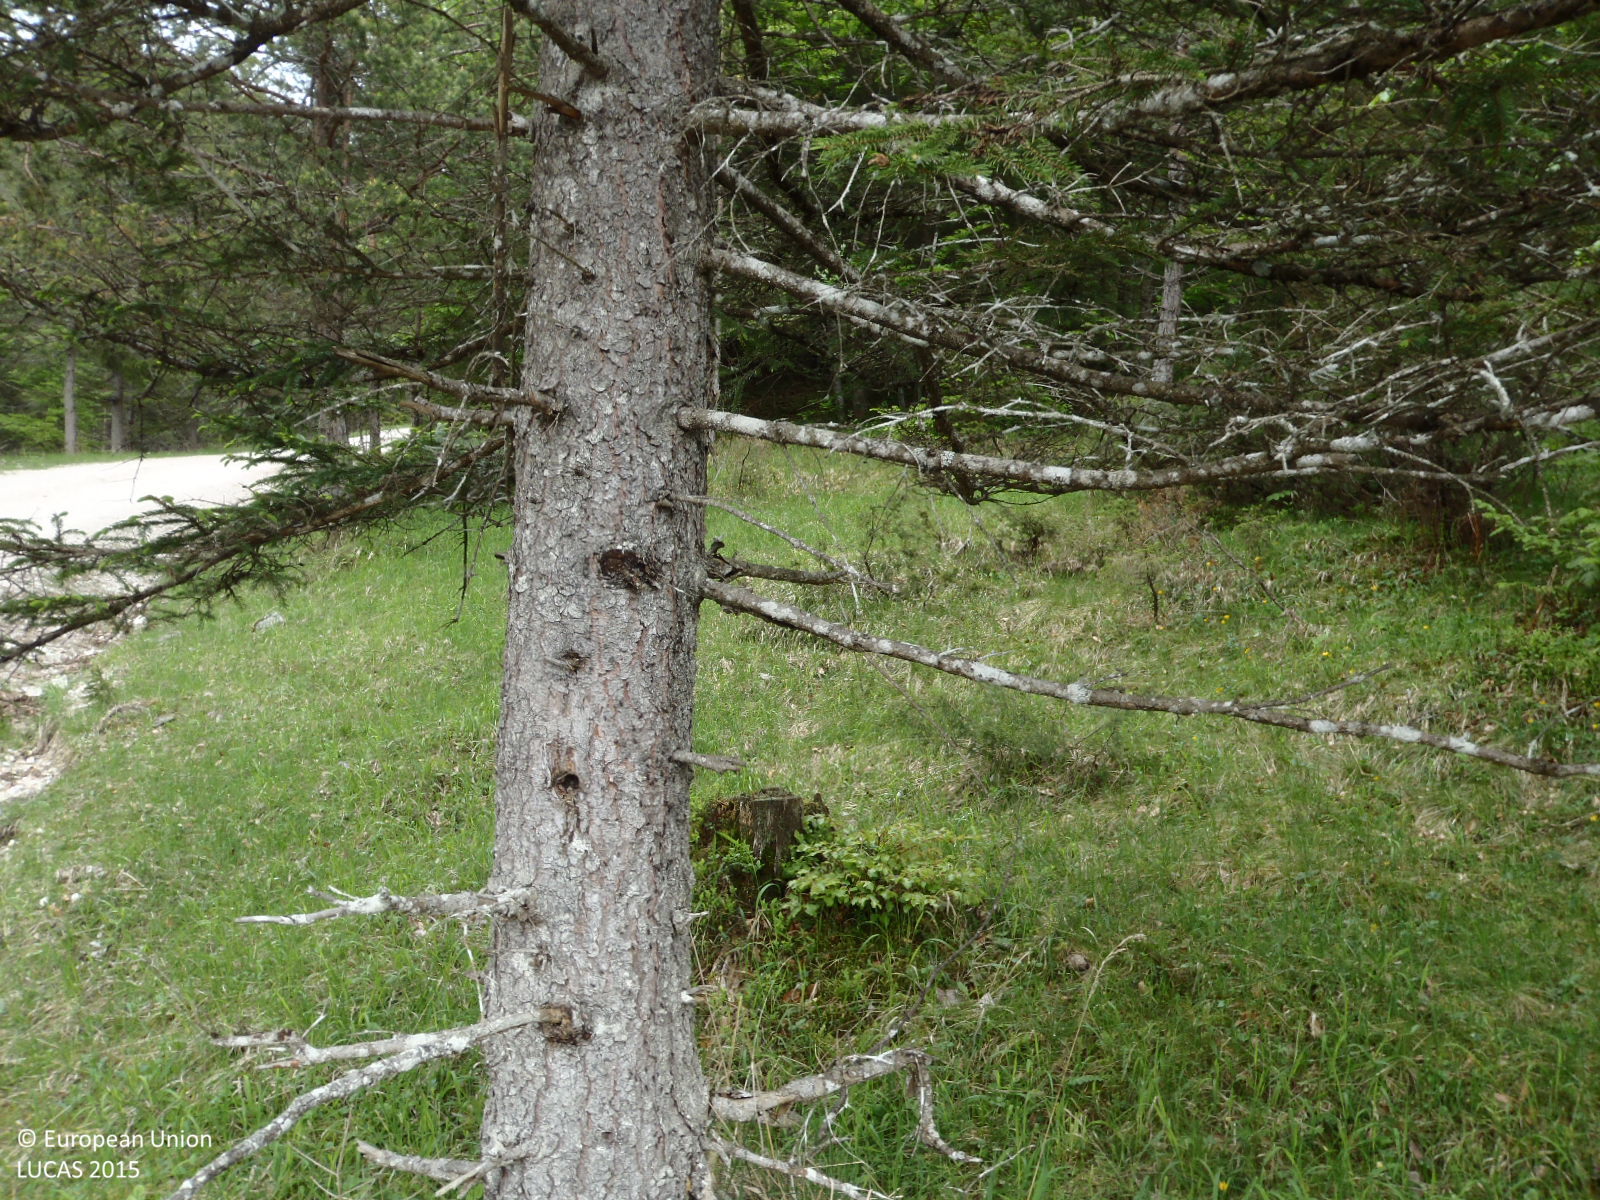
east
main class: Woodland
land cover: Other mixed woodland
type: alpine coniferous forest
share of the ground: > 75 %
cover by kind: coniferous forest trees 65 %, broadleaved forest trees 25 %, herbaceous plants 10 %
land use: Forestry
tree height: > 5 m
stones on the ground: < 10 %
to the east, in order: Other mixed woodland; Tracks; Grass margins; Spruce dominated coniferous woodland
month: May
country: AT
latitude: 47.5065
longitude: 11.8175
